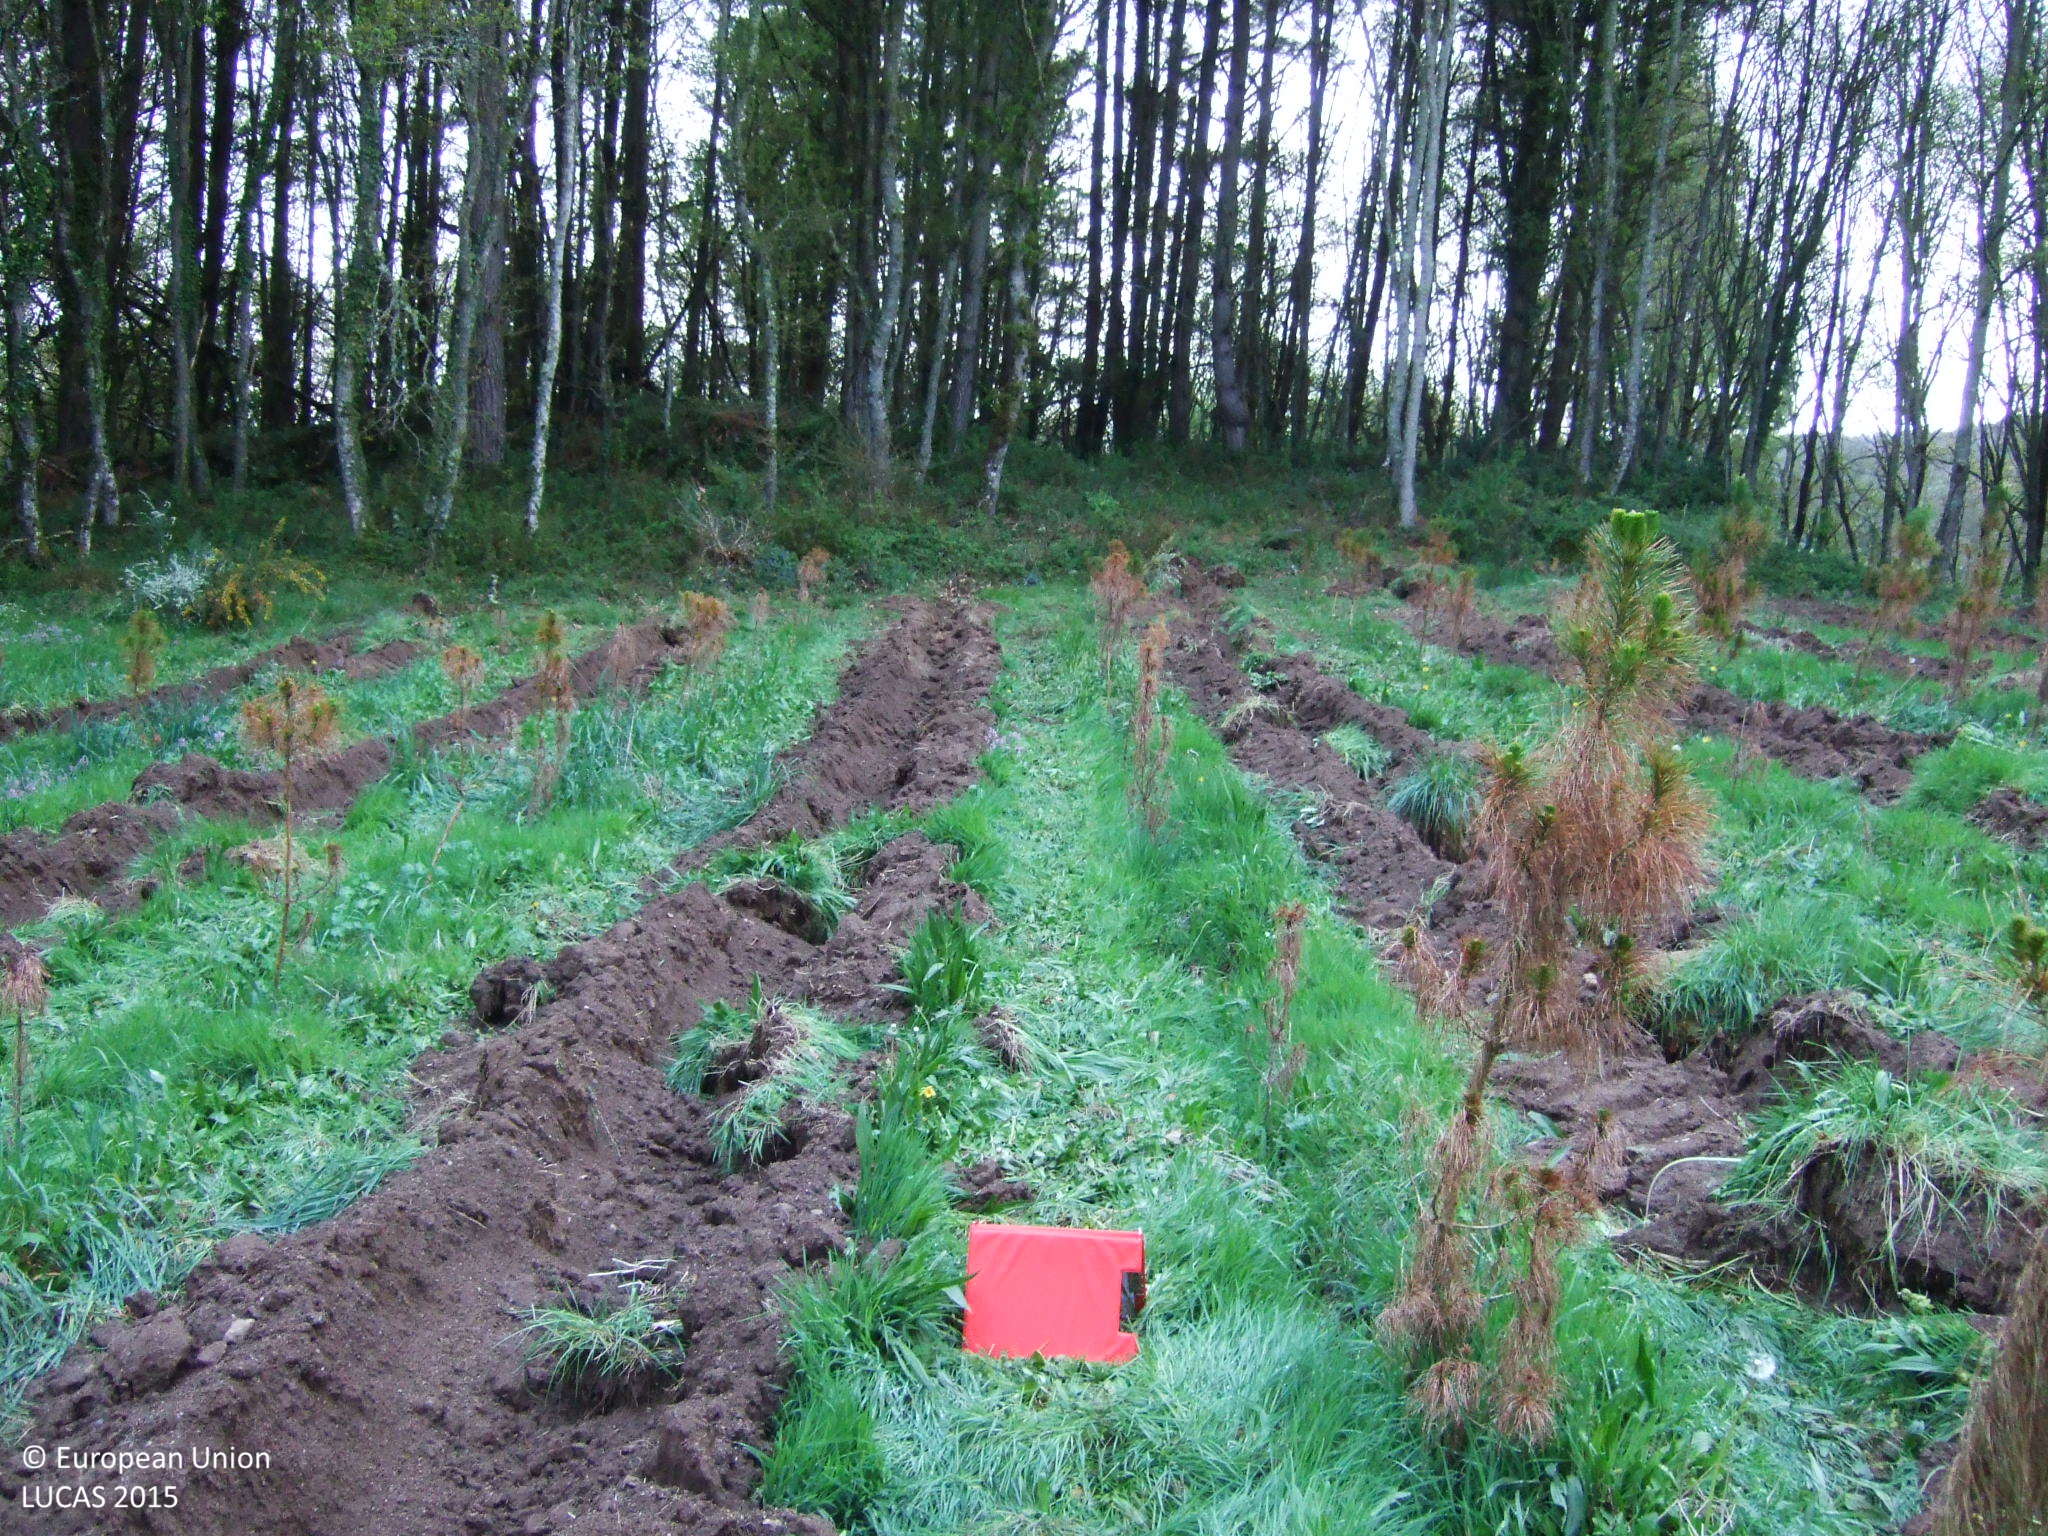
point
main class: Grassland
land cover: Grassland with sparse tree/shrub cover
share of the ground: > 75 %
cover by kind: herbaceous plants 80 %, unconsolidated bare surface 15 %, coniferous forest trees 5 %
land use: Forestry
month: April
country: ES
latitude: 42.9722
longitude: -7.3218
